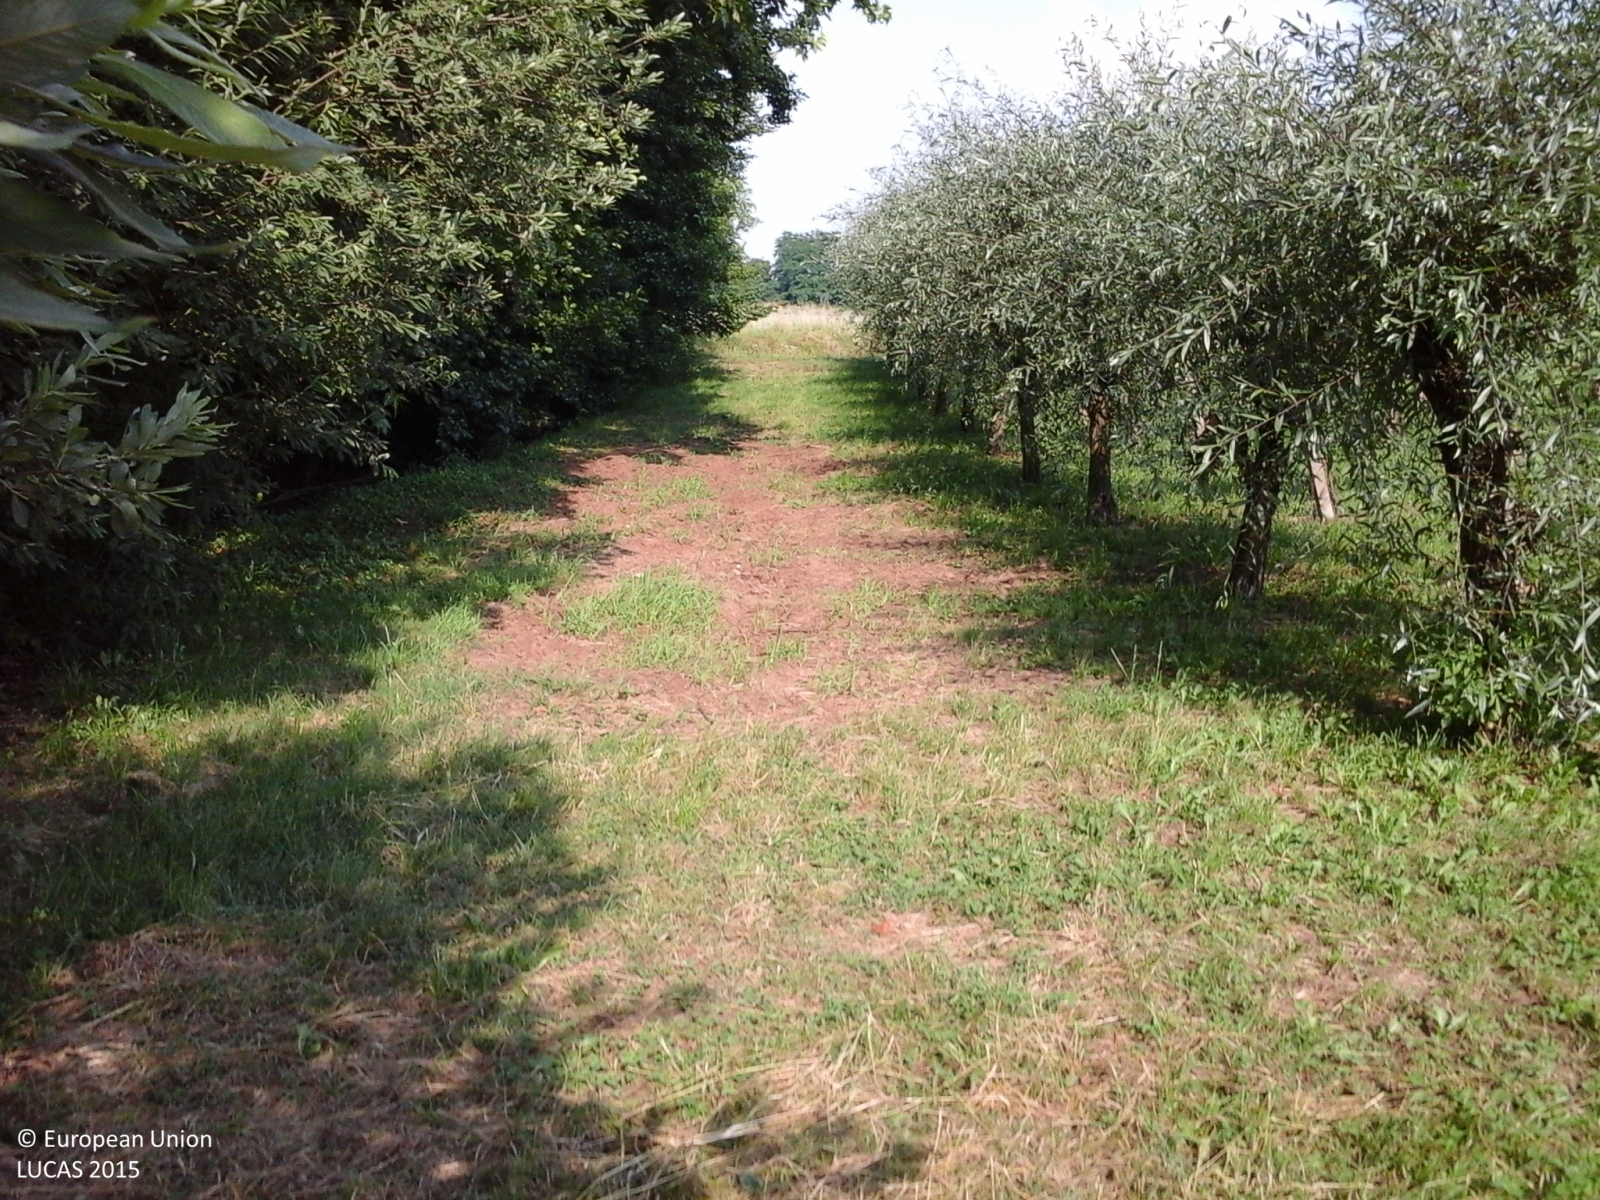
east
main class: Woodland
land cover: Broadleaved woodland
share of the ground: > 75 %
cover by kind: broadleaved forest trees 100 %
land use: Forestry
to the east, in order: Broadleaved woodland; Grass margins; Inland fresh running water; Spontaneously vegetated surfaces; Ditches and canals; Spontaneously vegetated surfaces; Ditches and canals; Spontaneously vegetated surfaces
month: June
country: IT
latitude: 45.7085
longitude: 11.6032
